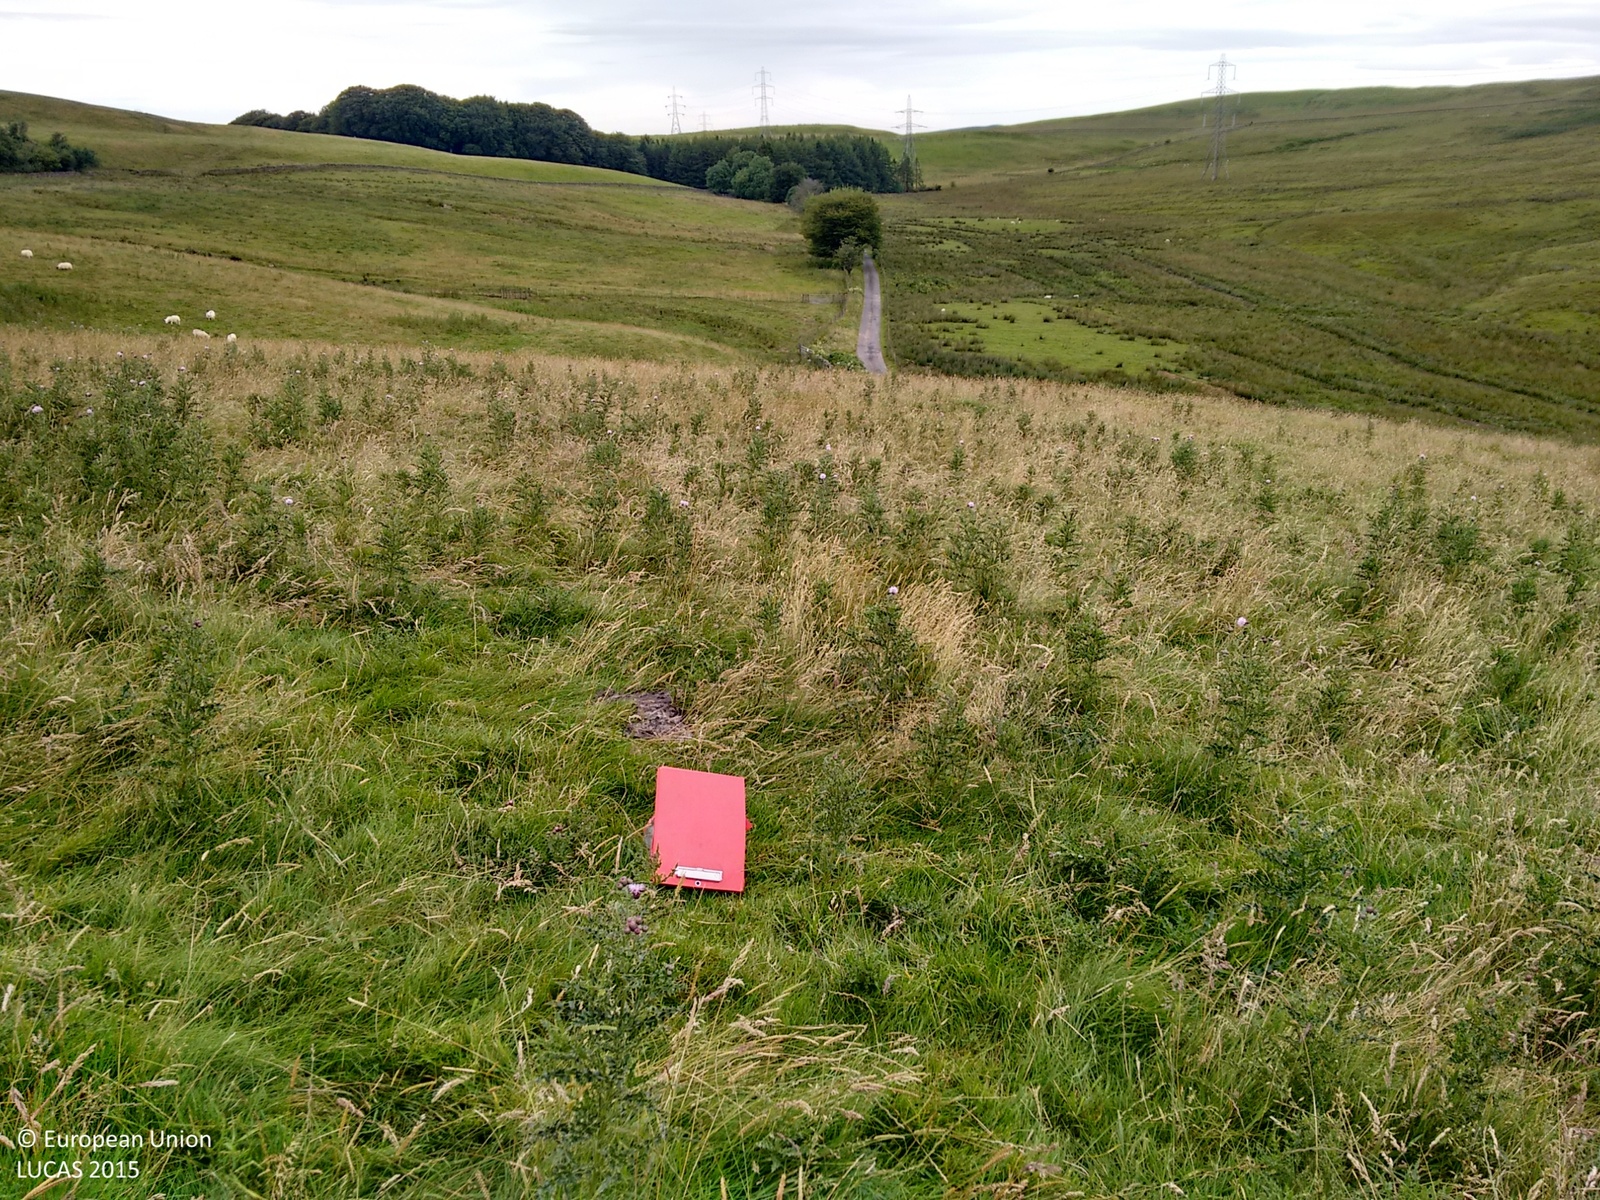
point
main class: Grassland
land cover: Grassland without tree/shrub cover
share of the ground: > 75 %
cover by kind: herbaceous plants 100 %
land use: Agriculture (excluding fallow land and kitchen gardens)
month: August
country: GB
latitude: 55.1619
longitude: -3.3085
